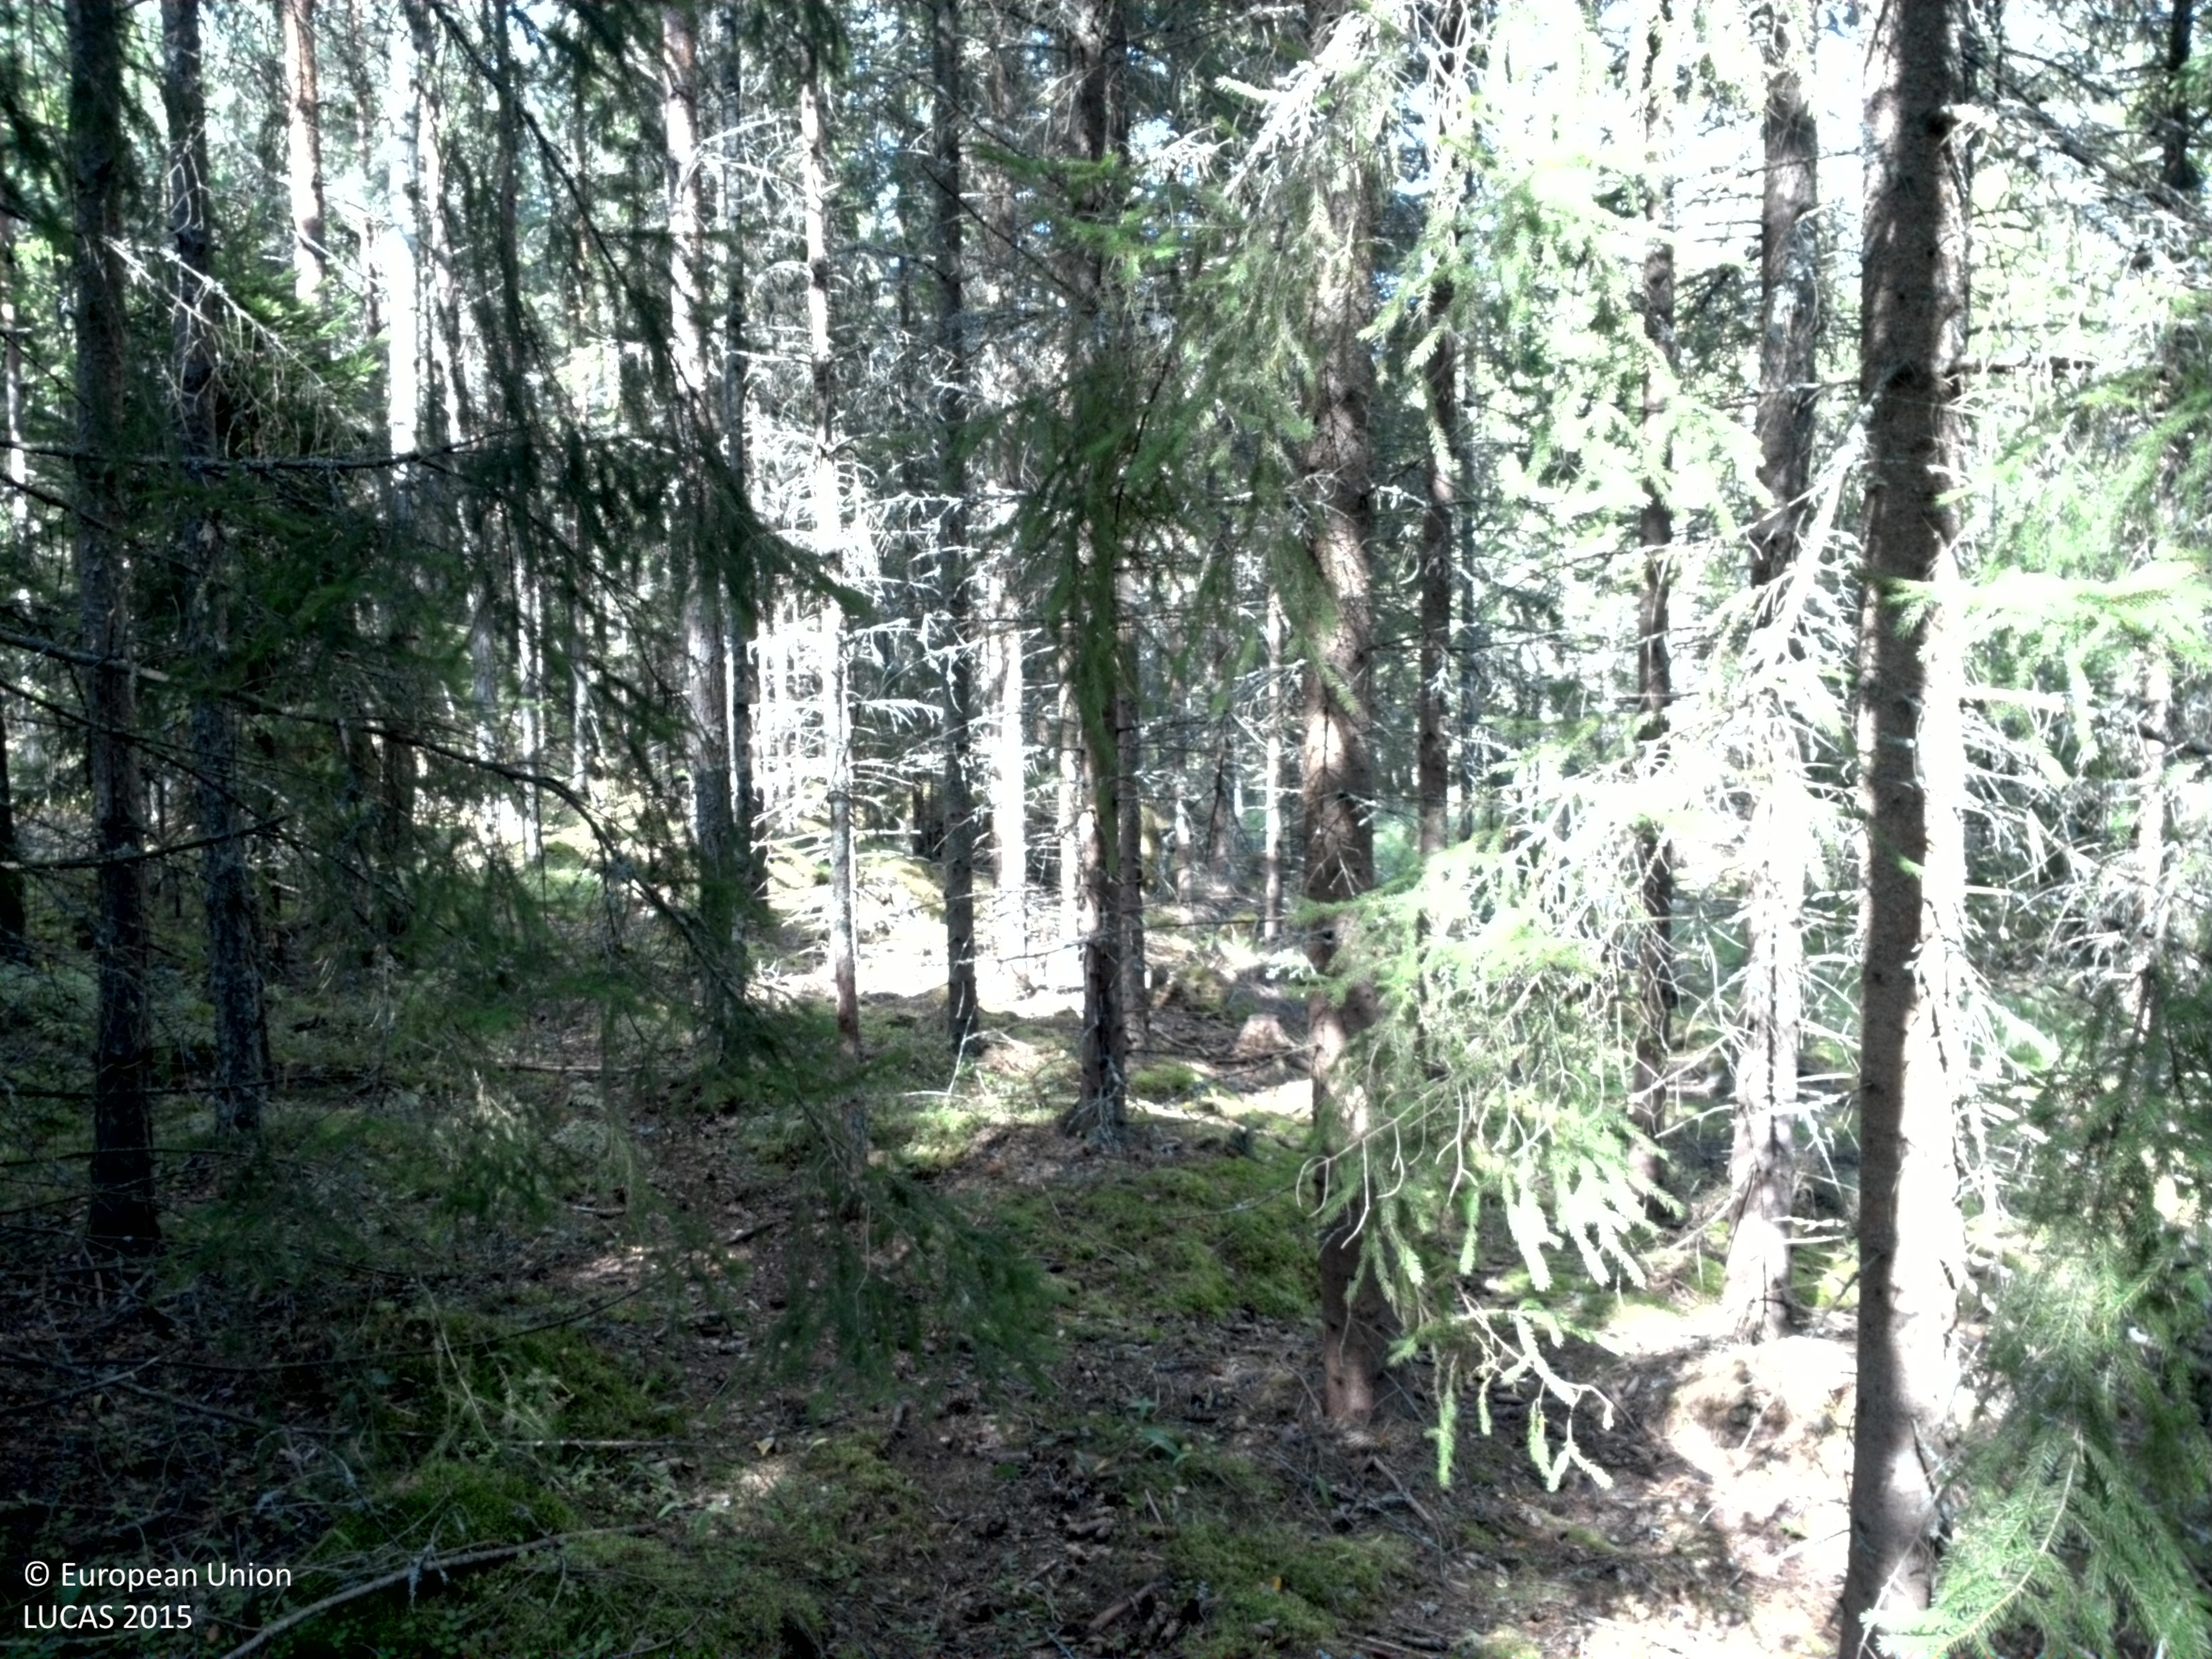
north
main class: Woodland
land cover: Spruce dominated coniferous woodland
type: boreal forest
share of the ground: 50 - 75 %
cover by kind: coniferous forest trees 70 %, lichens and mosses 20 %, broadleaved forest trees 5 %, shrubs 5 %
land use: Forestry
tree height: > 5 m
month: August
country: SE
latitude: 59.6112
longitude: 16.9582
